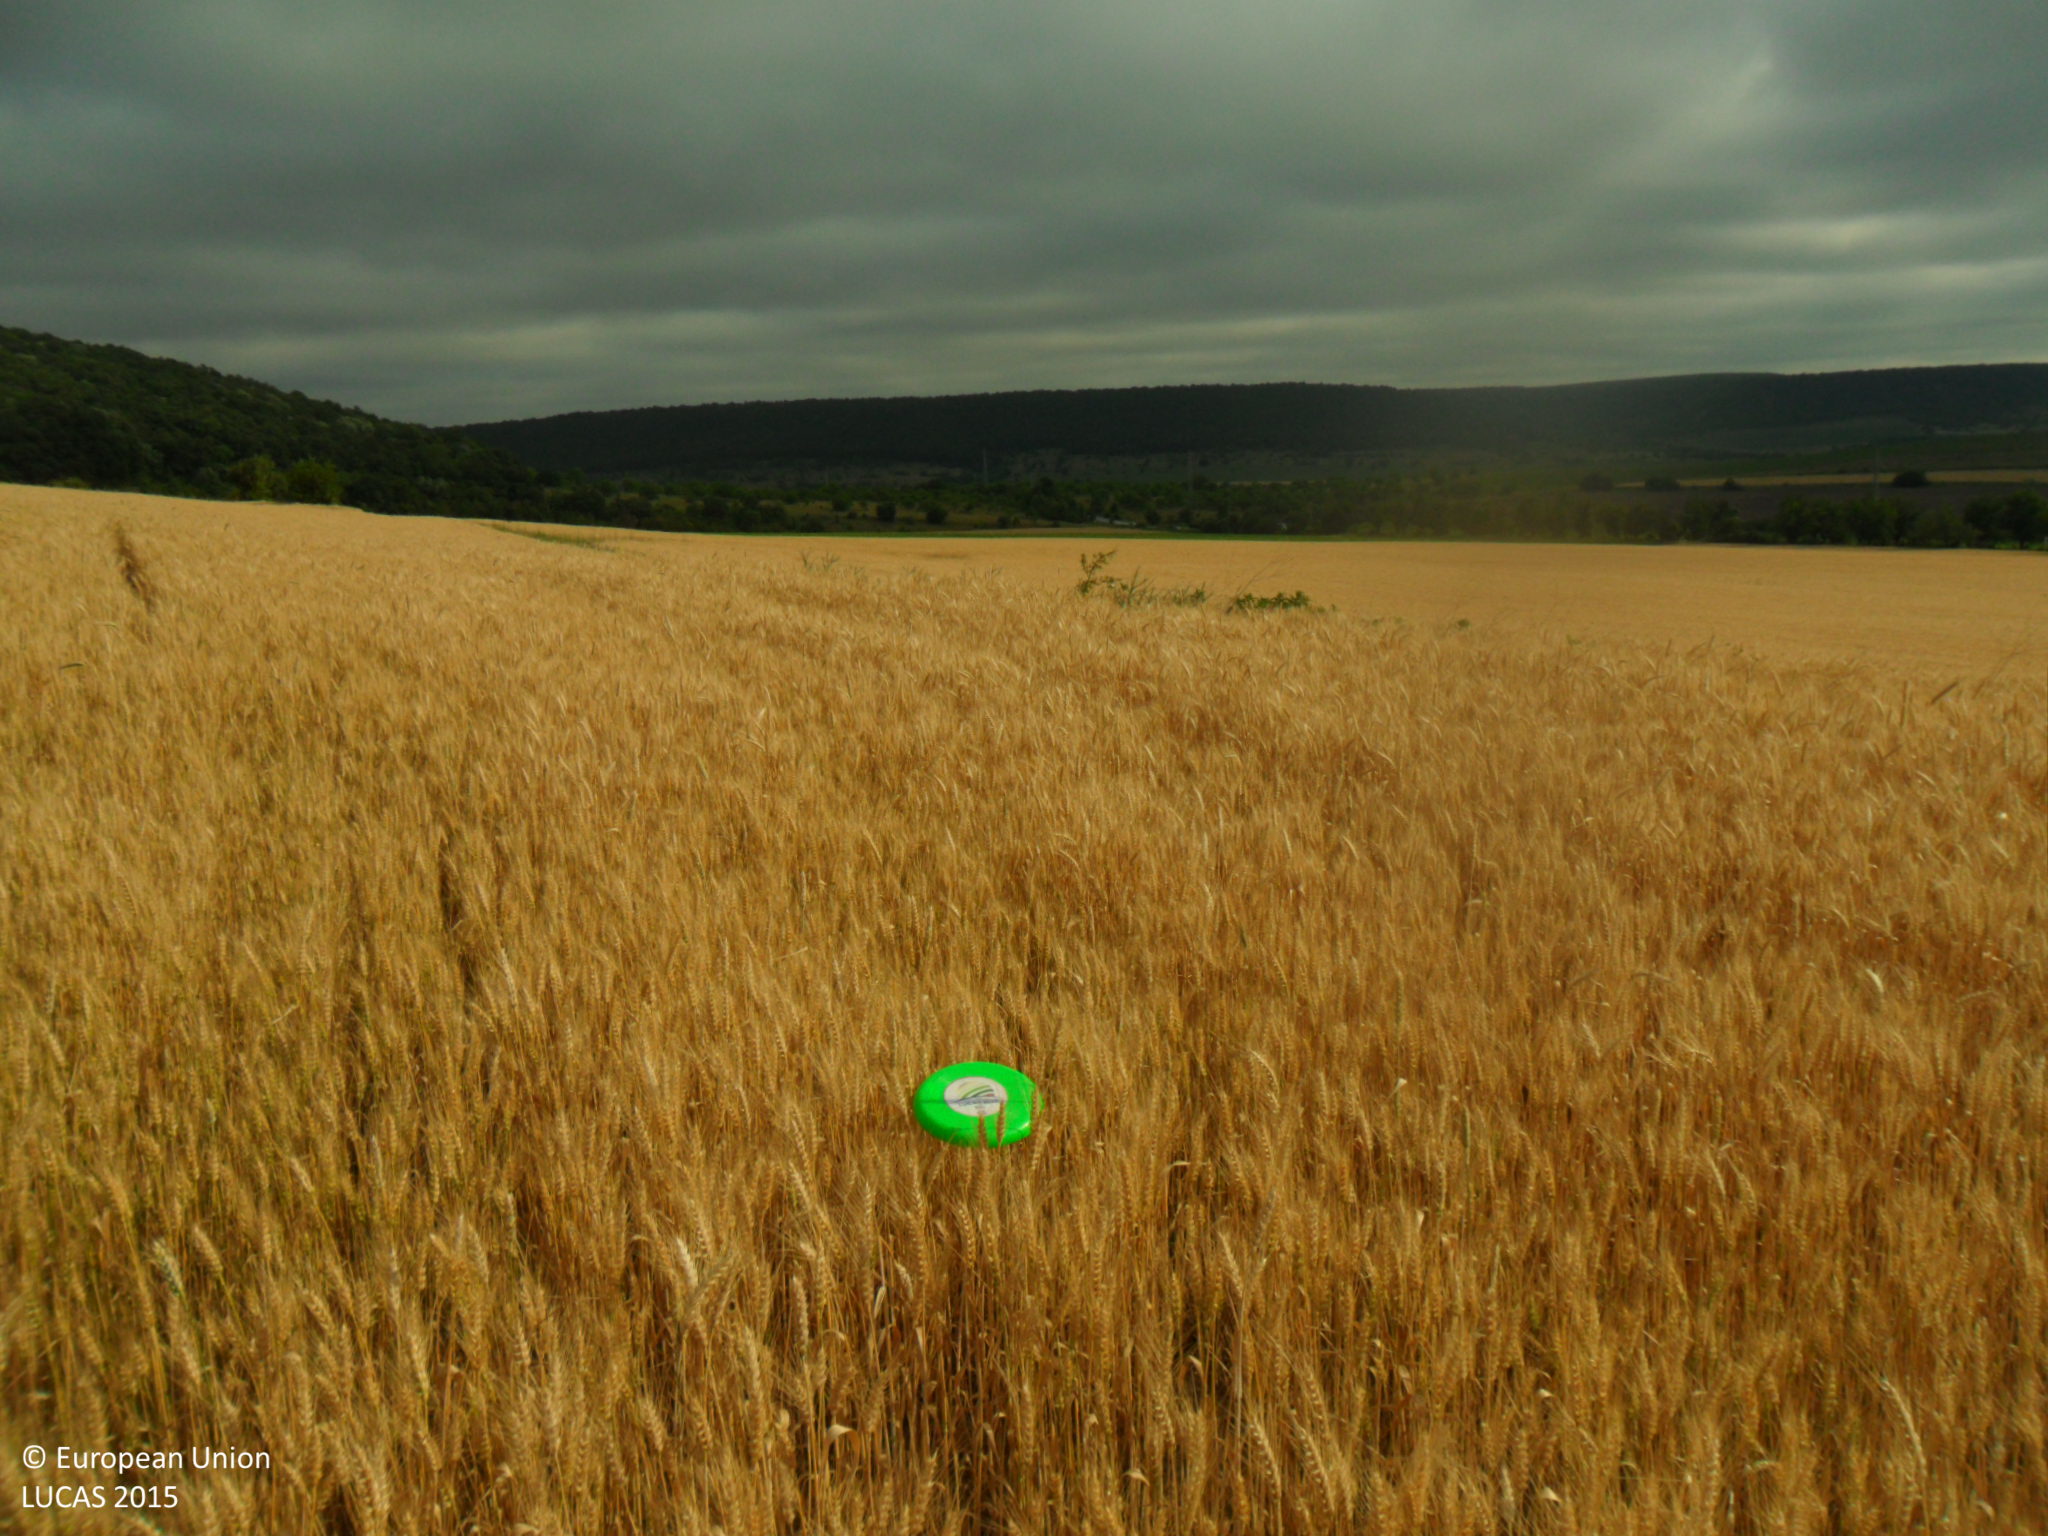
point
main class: Cropland
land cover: Common wheat
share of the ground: > 75 %
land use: Agriculture (excluding fallow land and kitchen gardens)
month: June
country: BG
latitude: 43.4852
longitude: 27.1216
